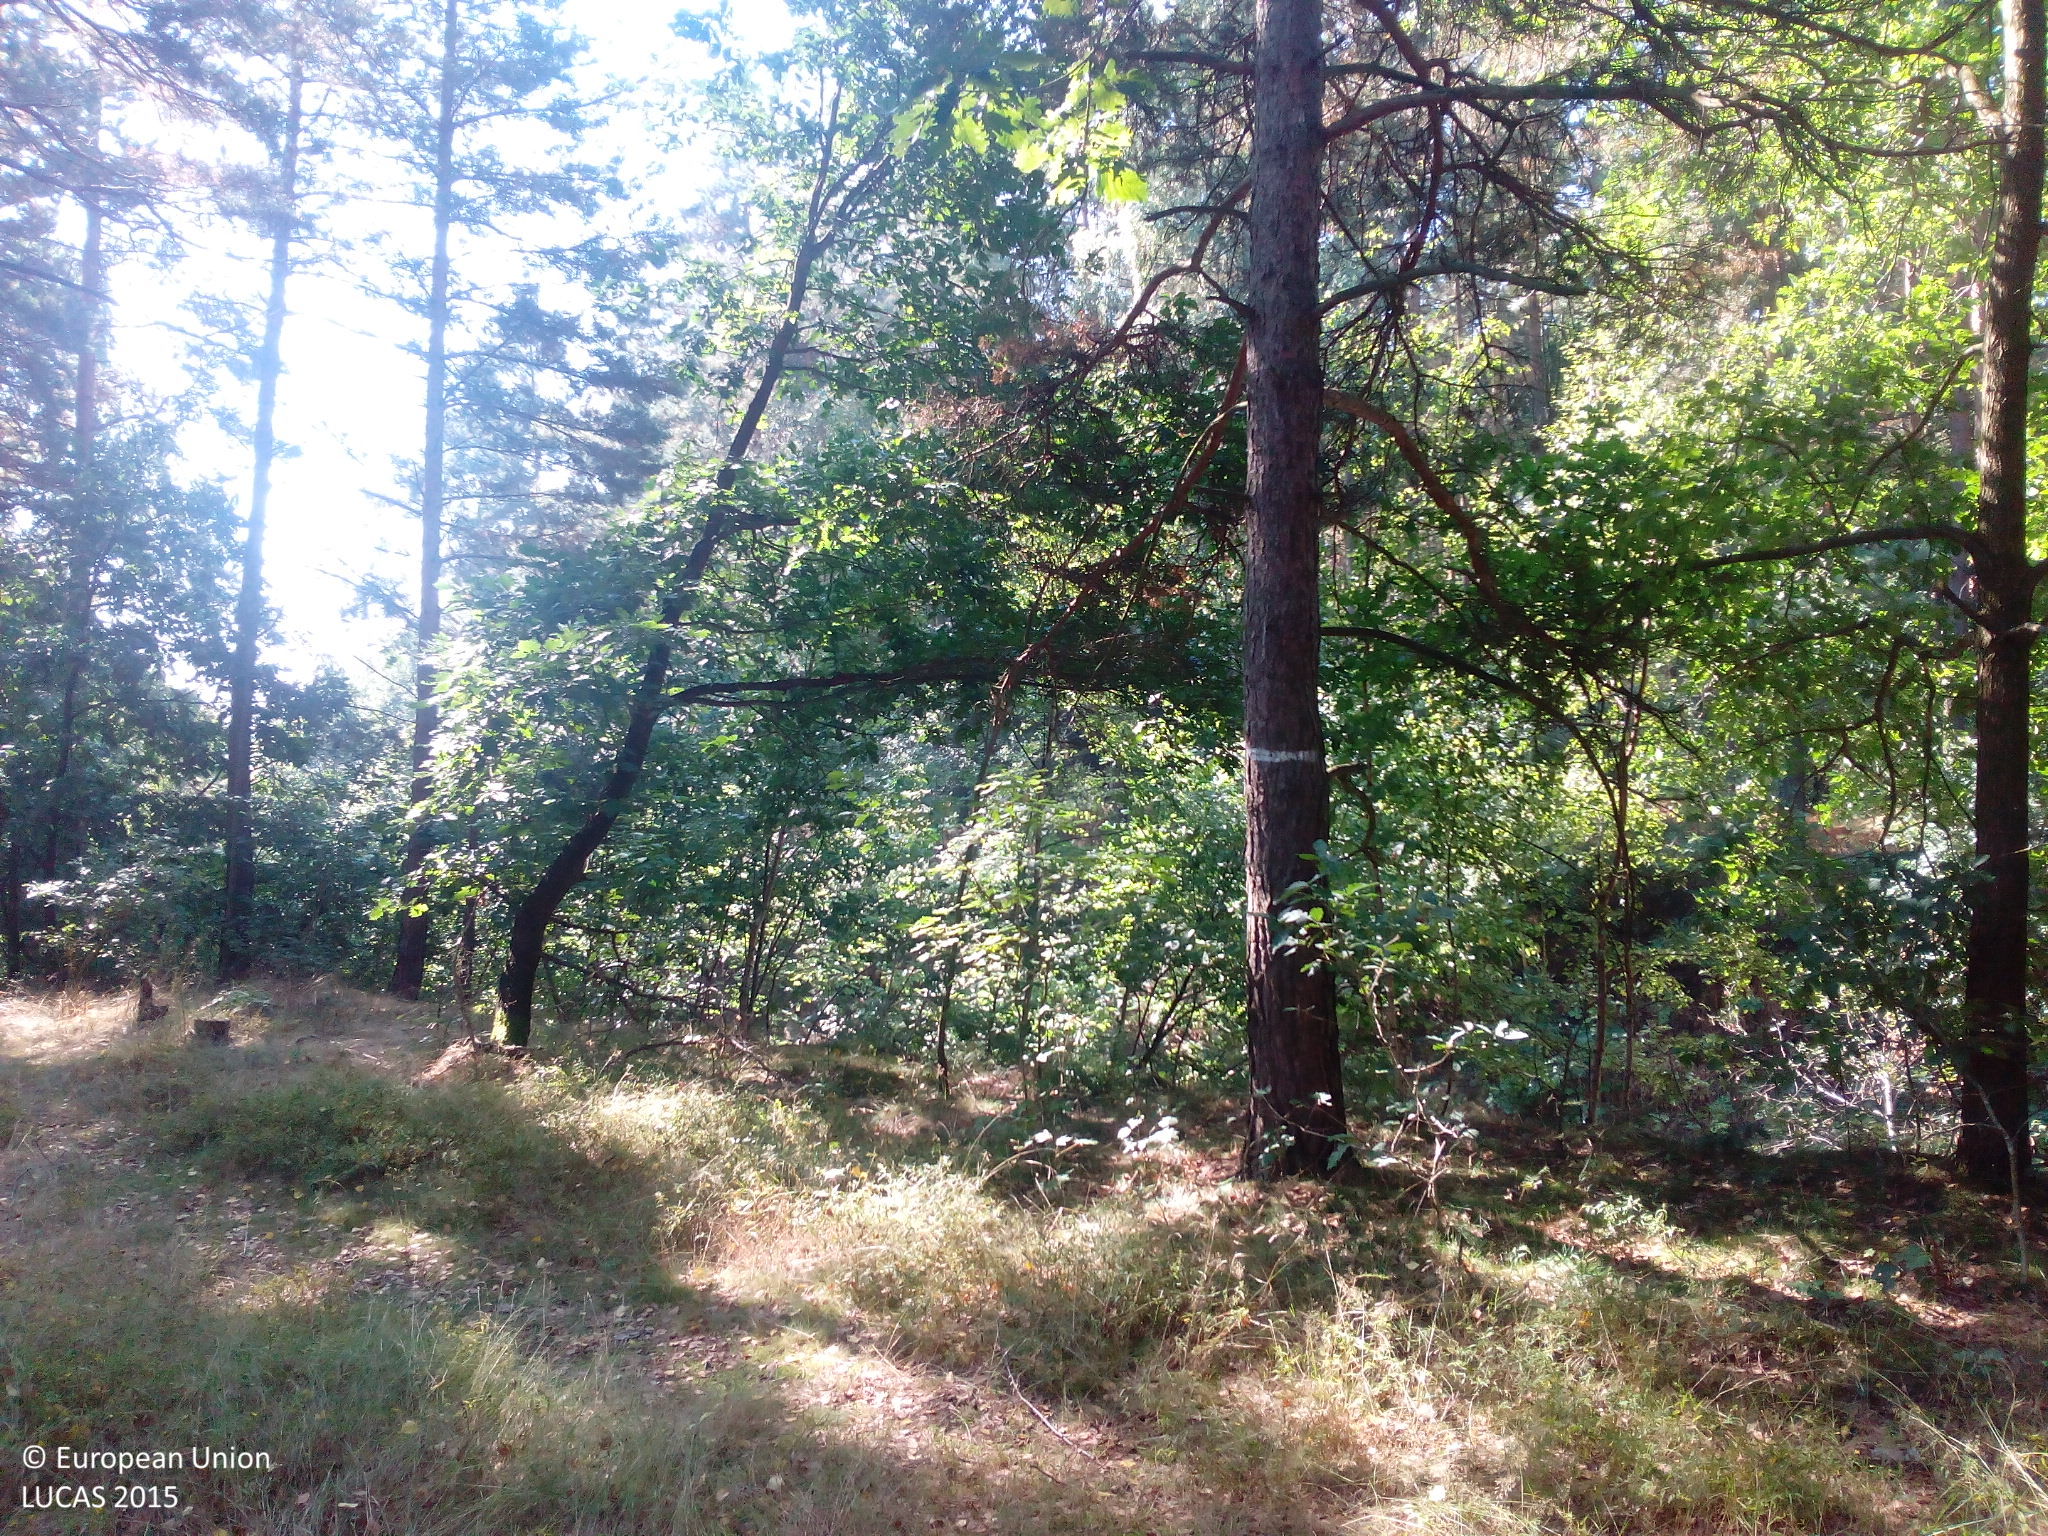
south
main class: Woodland
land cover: Pine dominated mixed woodland
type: hemiboreal forest and nemoral coniferous forest and mixed broadleaved-coniferous forest
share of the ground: > 75 %
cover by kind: coniferous forest trees 75 %, broadleaved forest trees 25 %
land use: Forestry
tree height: > 5 m
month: August
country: DE
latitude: 50.8874
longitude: 14.0240
